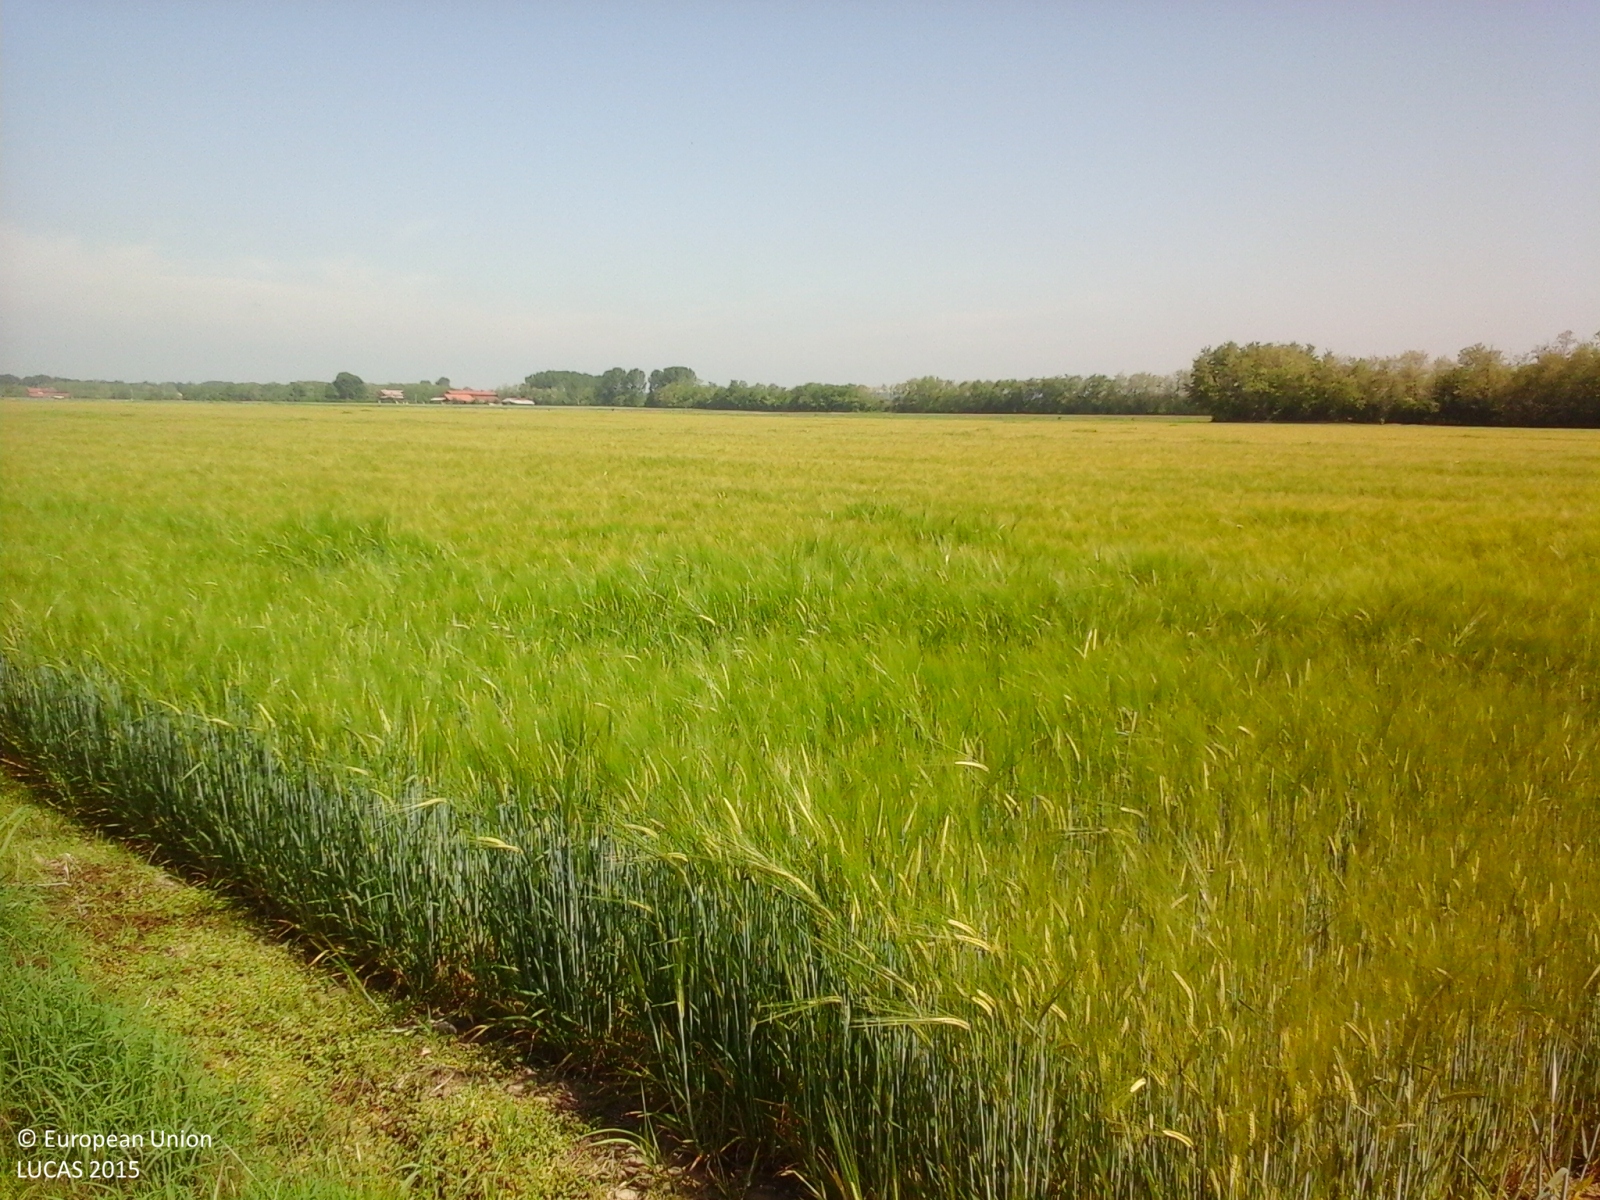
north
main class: Grassland
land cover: Grassland without tree/shrub cover
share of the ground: > 75 %
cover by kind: herbaceous plants 100 %
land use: Agriculture (excluding fallow land and kitchen gardens)
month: May
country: IT
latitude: 45.5670
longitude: 8.5801
